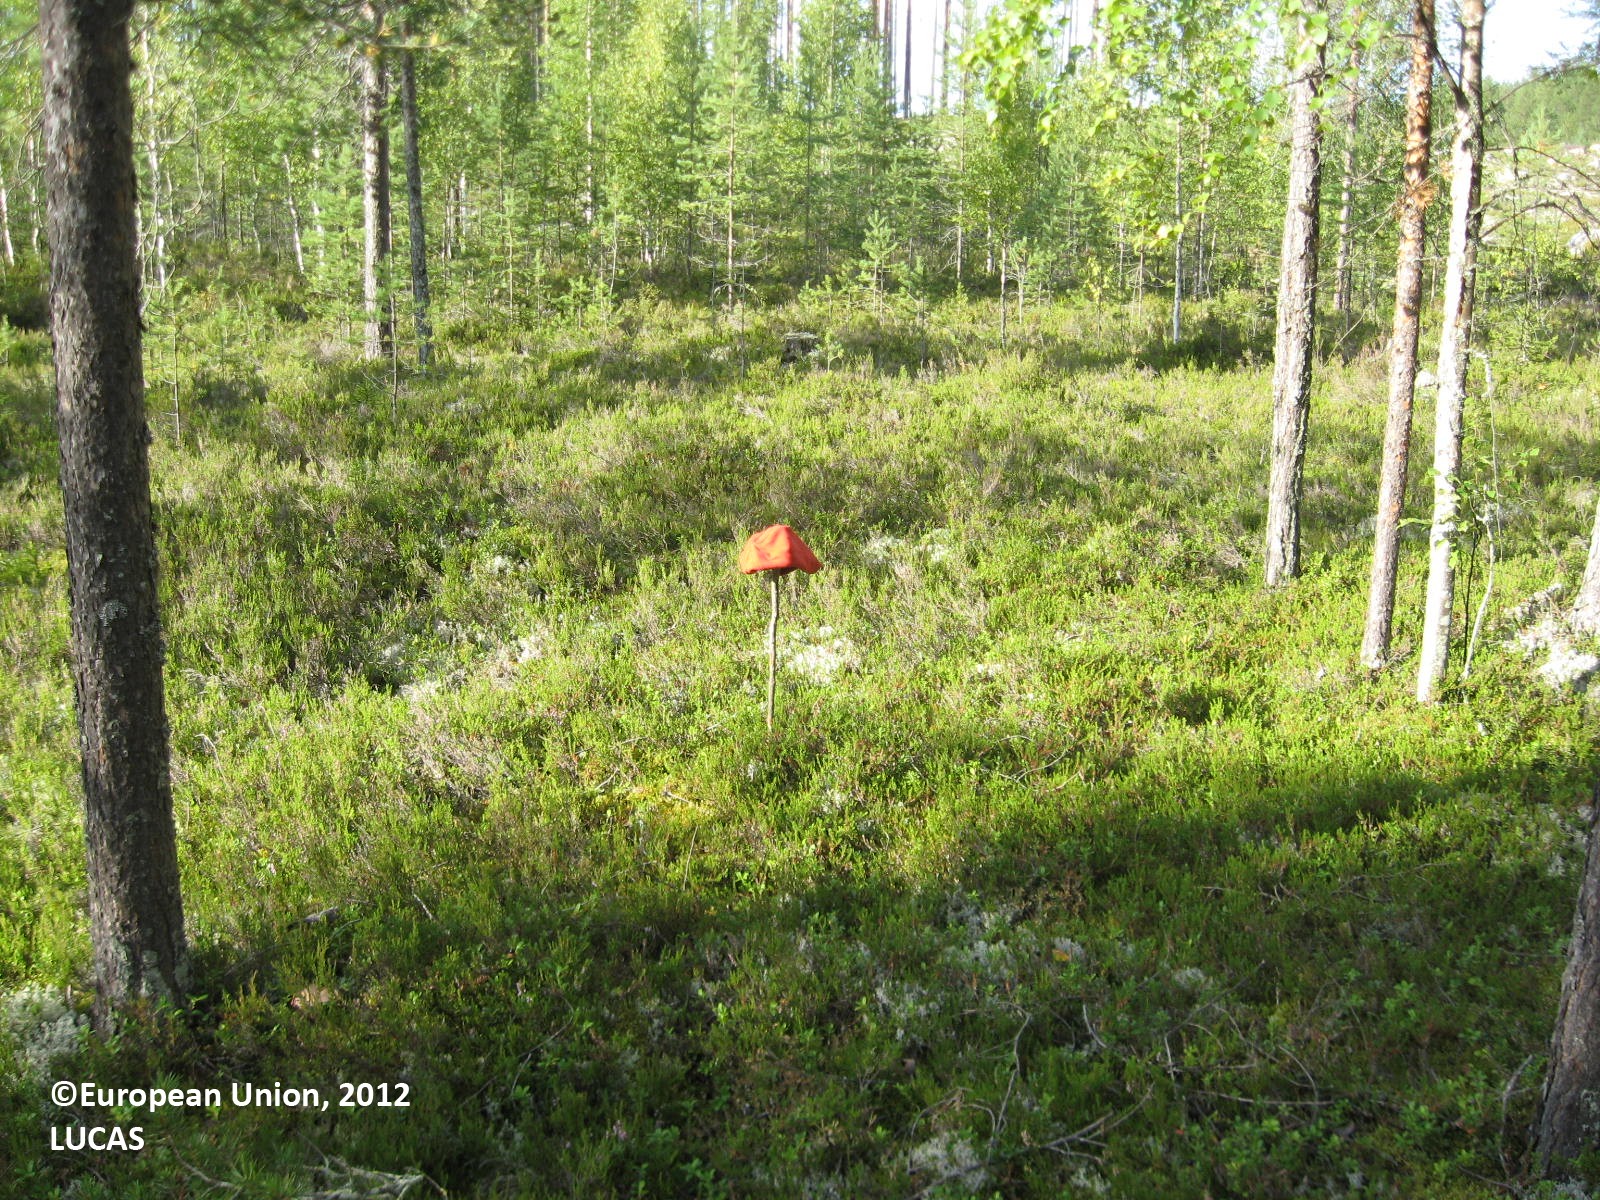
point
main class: Woodland
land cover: Pine dominated coniferous woodland
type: boreal forest
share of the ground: > 75 %
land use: Forestry
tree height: > 5 m
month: August
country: FI
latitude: 63.5988
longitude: 29.6433
